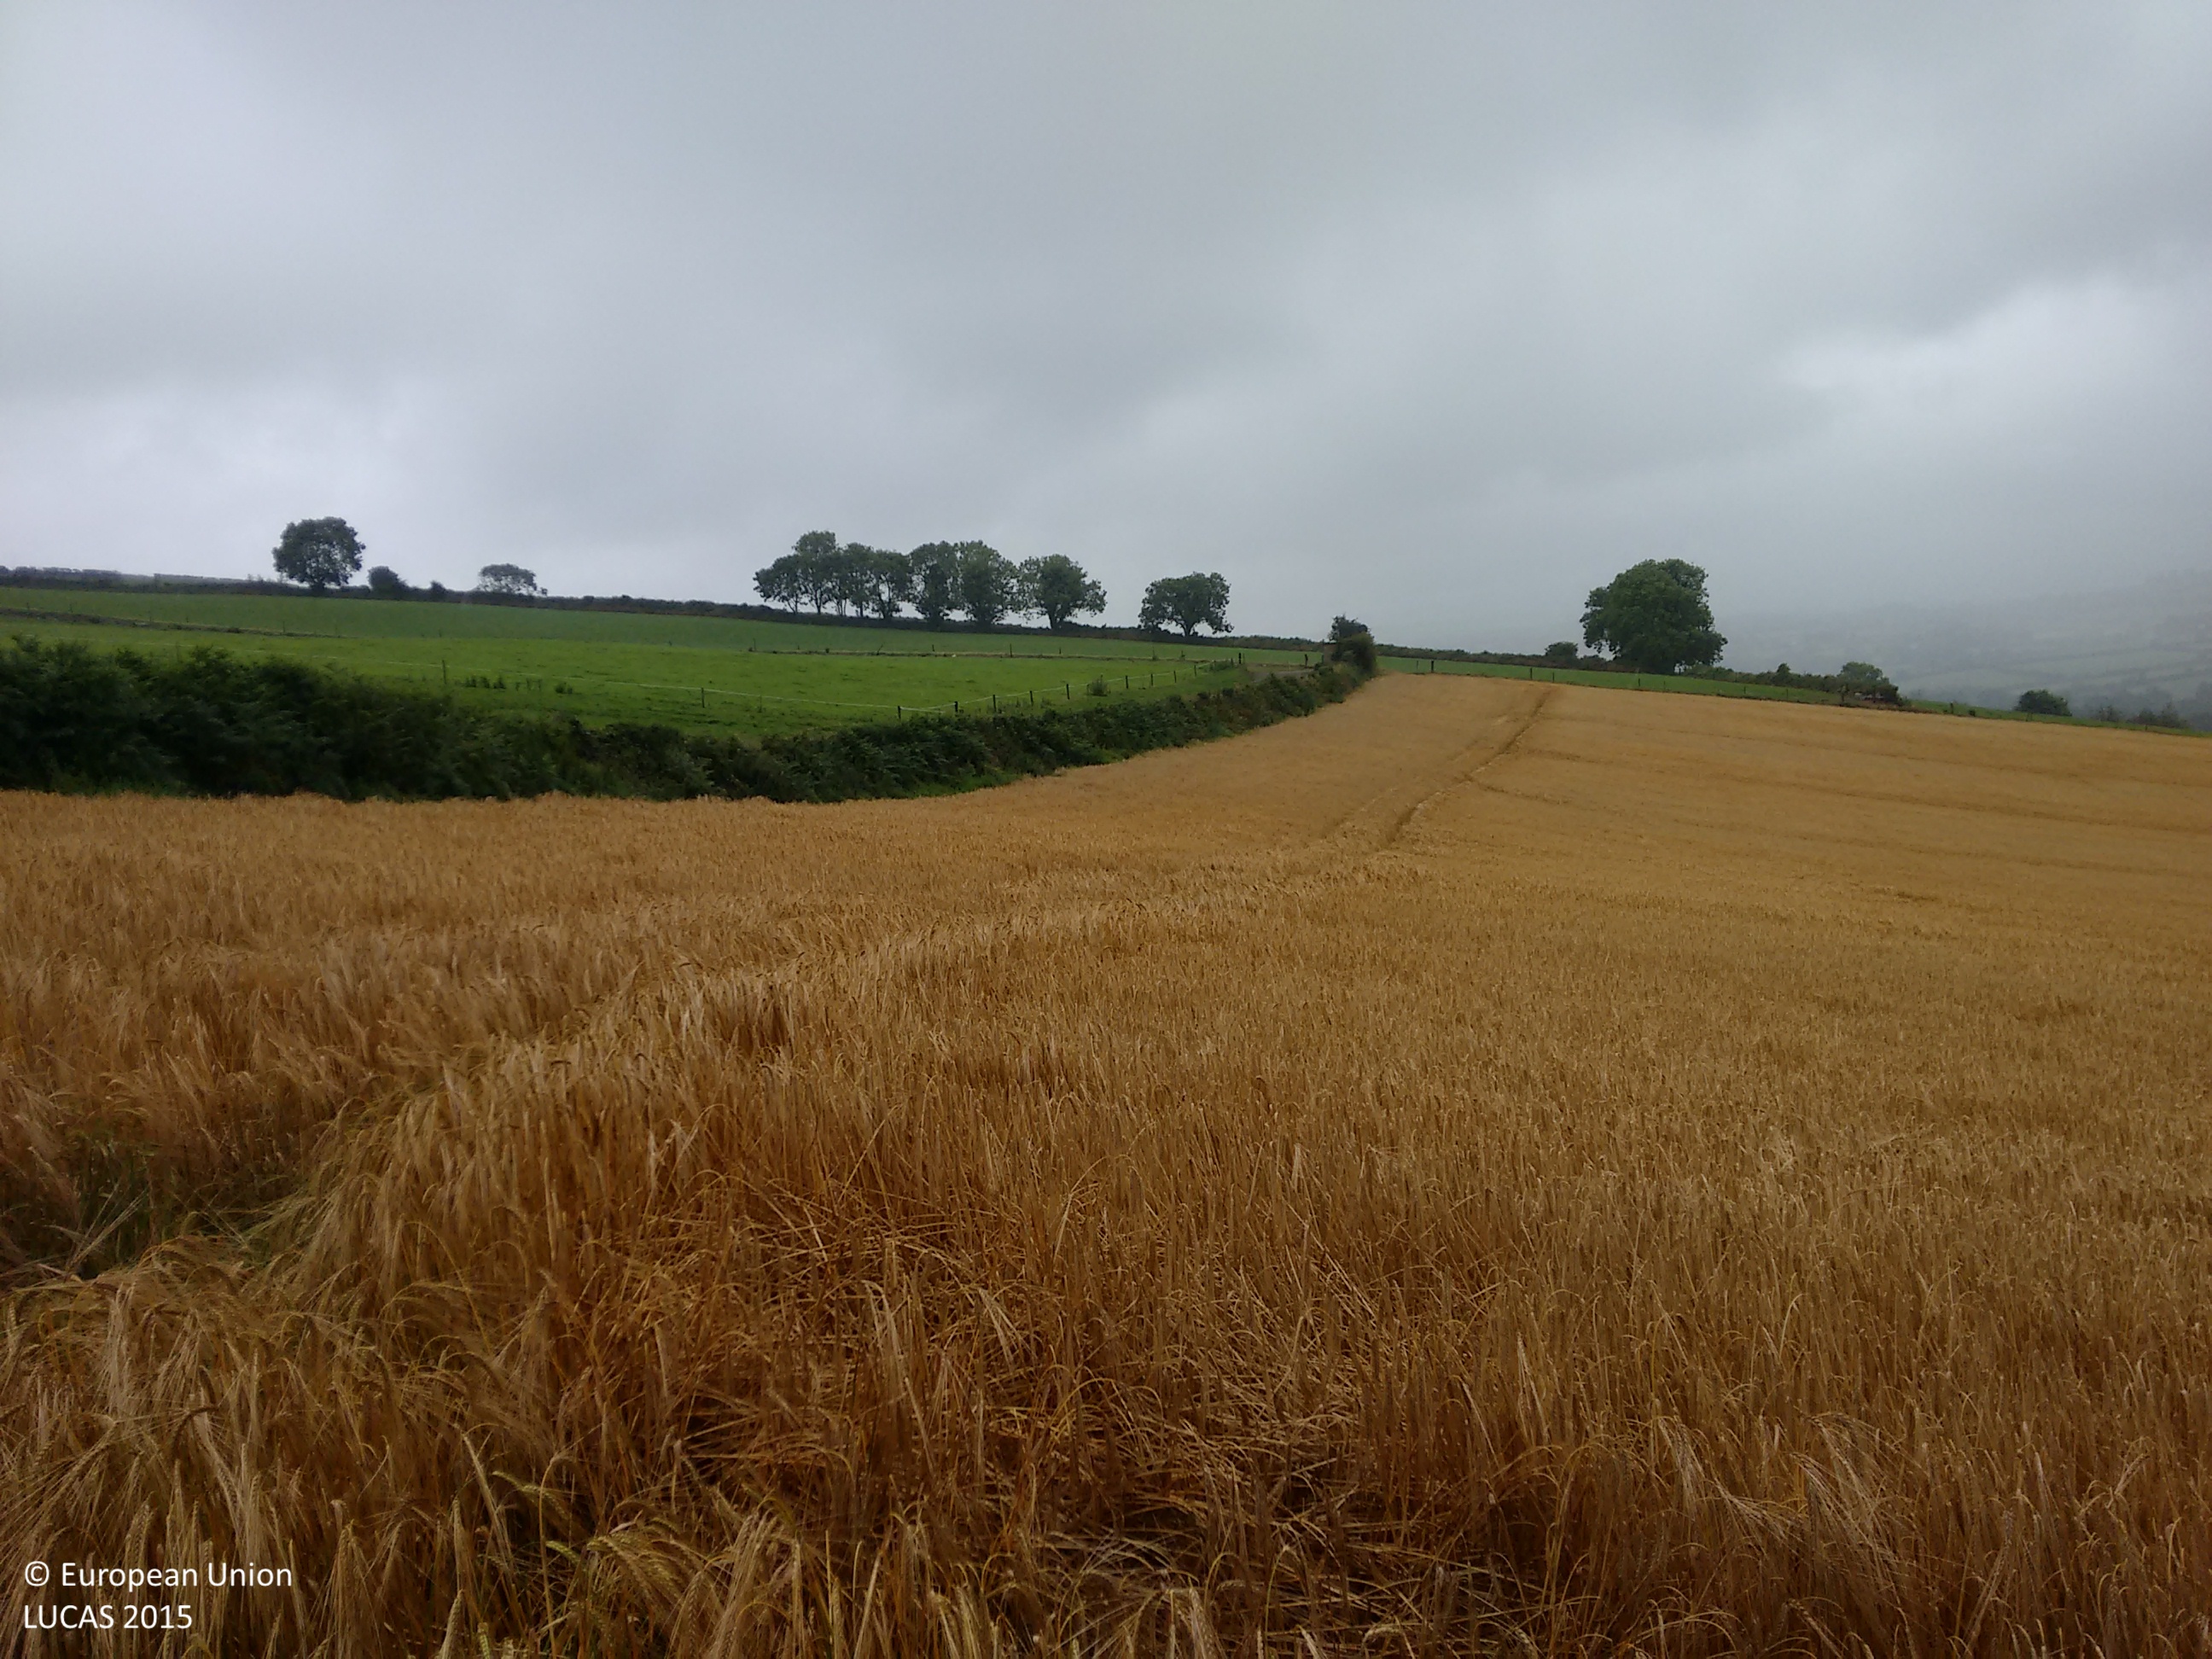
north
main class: Cropland
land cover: Barley
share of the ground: > 75 %
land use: Agriculture (excluding fallow land and kitchen gardens)
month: August
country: IE
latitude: 52.6930
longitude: -6.4152
